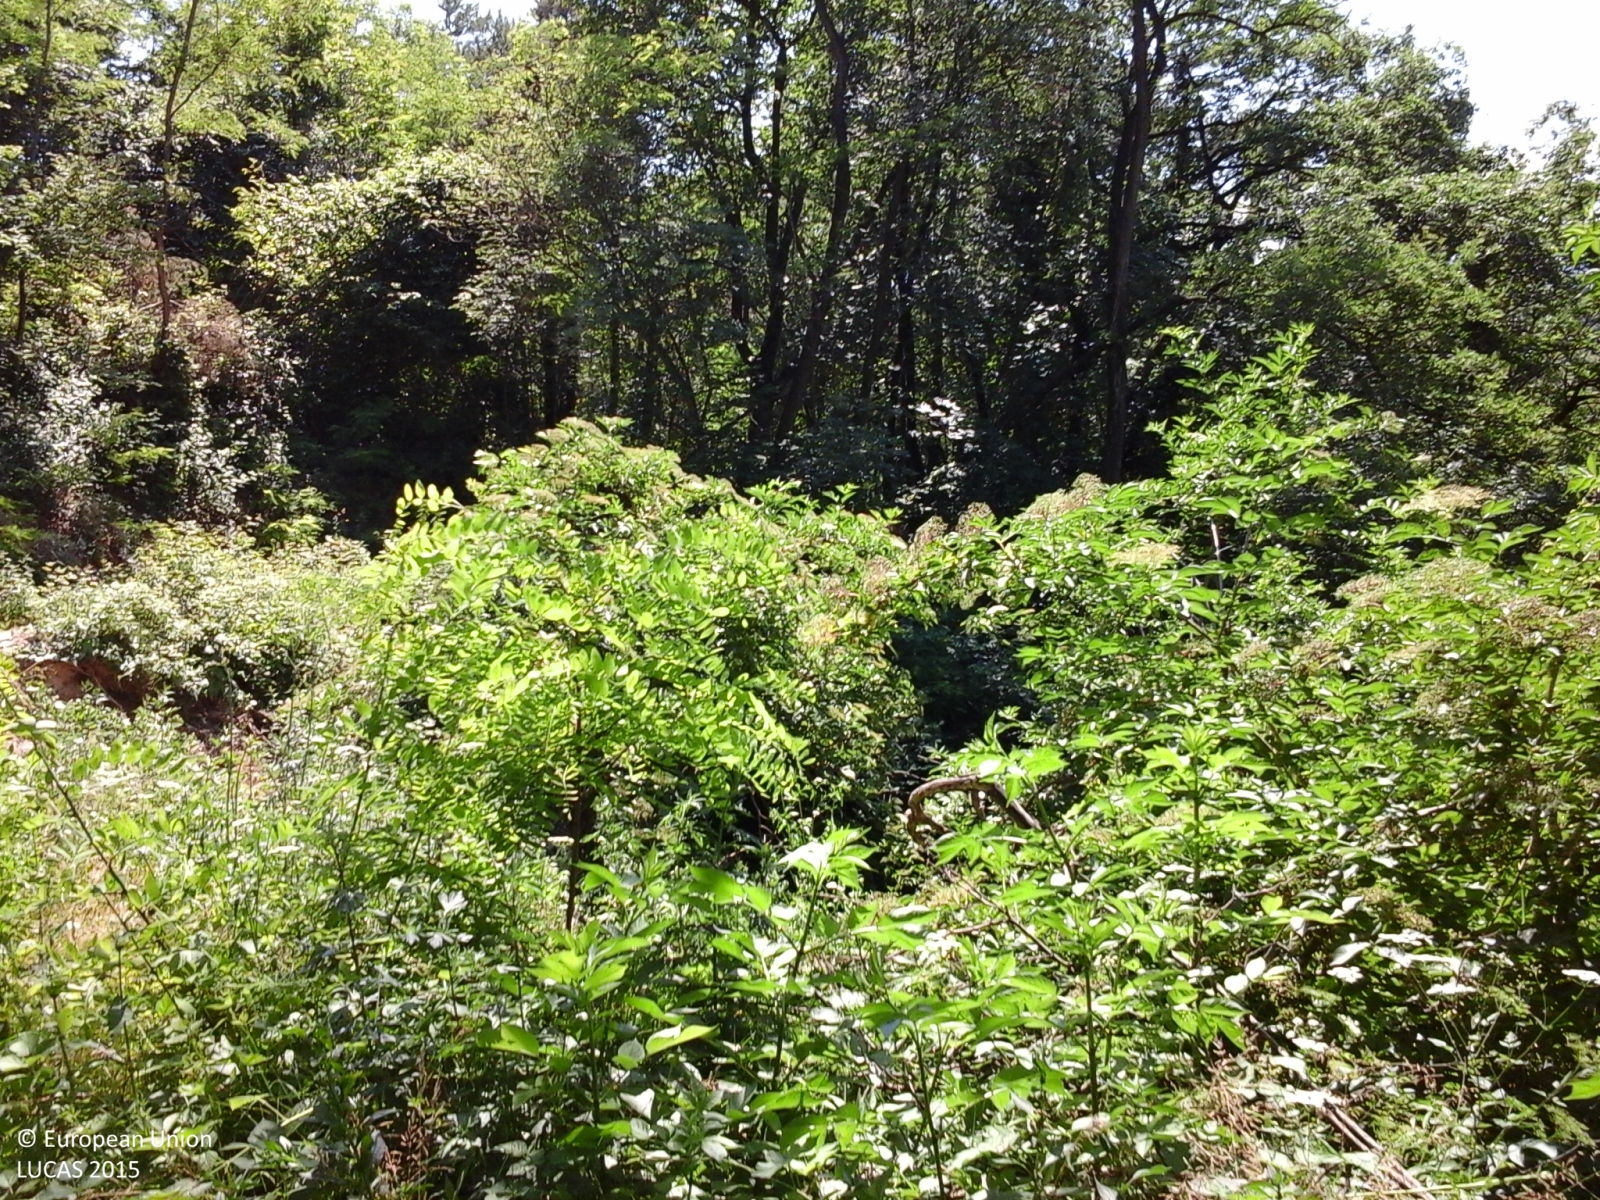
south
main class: Woodland
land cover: Broadleaved woodland
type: mesophytic deciduous forest
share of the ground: > 75 %
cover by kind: broadleaved forest trees 90 %, shrubs 10 %
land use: Forestry
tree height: > 5 m
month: June
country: IT
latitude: 44.6060
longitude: 8.2271
